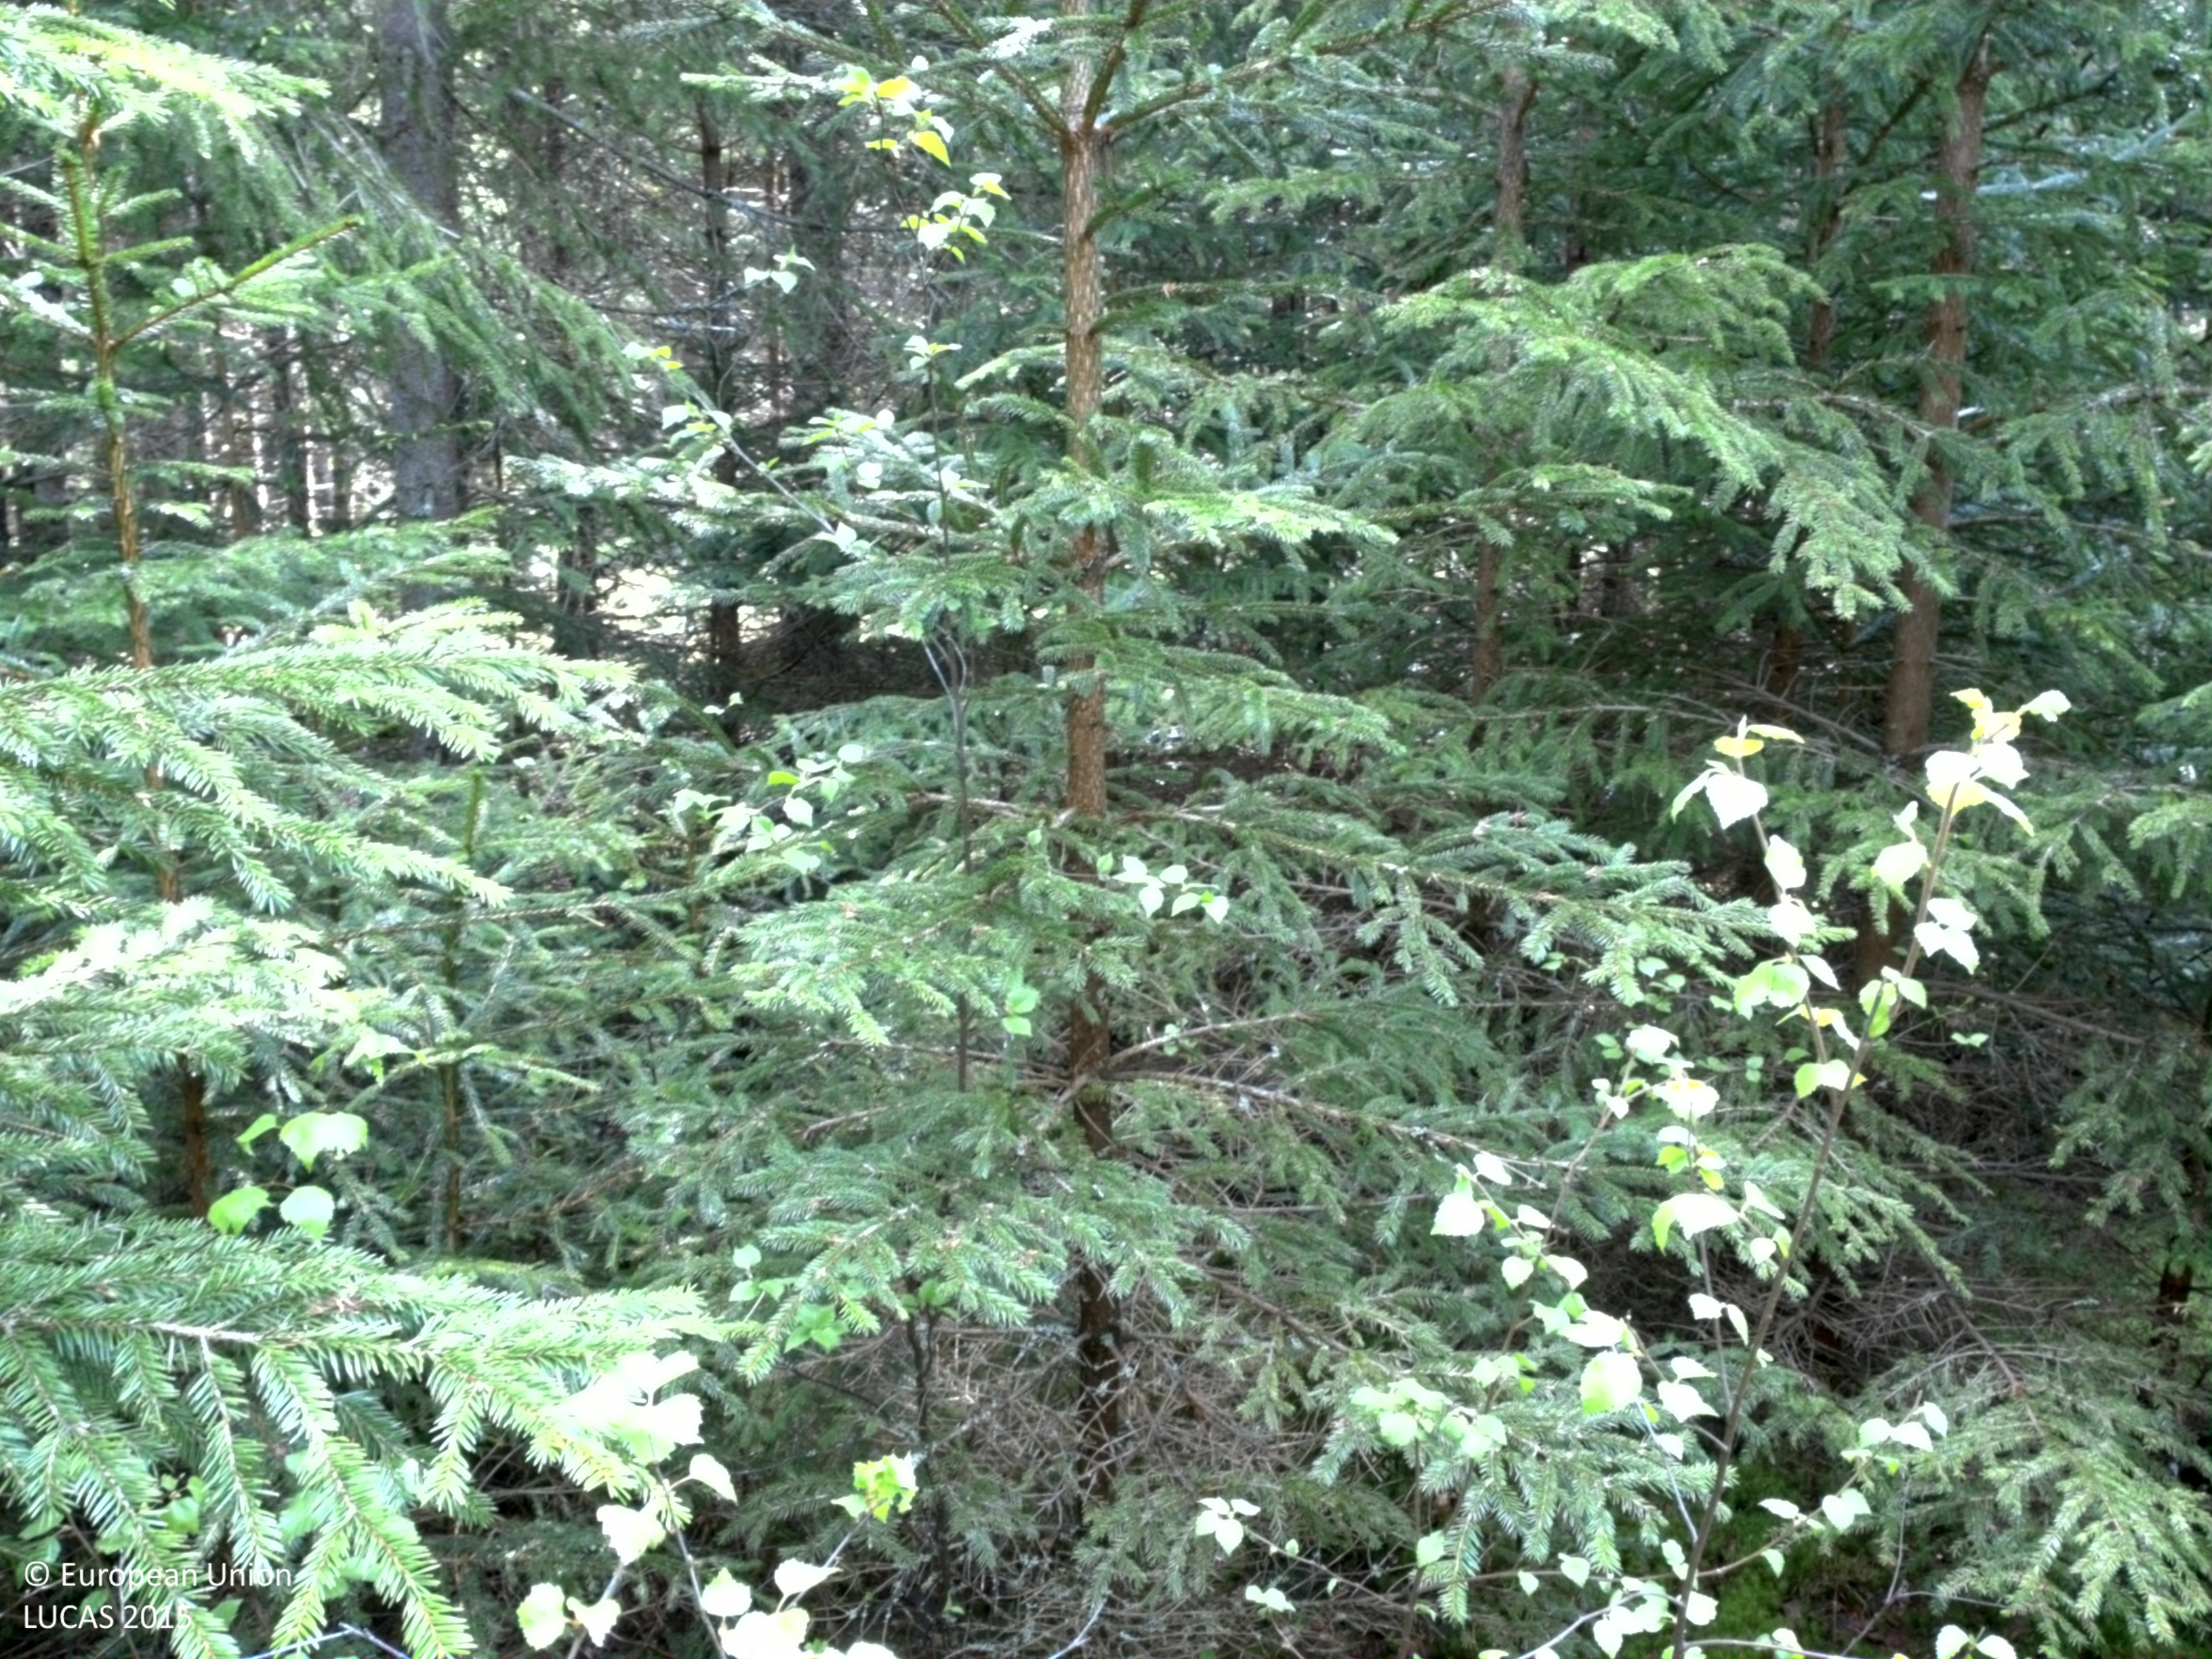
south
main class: Woodland
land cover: Spruce dominated mixed woodland
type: boreal forest
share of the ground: > 75 %
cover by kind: coniferous forest trees 75 %, broadleaved forest trees 25 %
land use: Forestry
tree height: < 5 m
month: May
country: SE
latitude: 56.5752
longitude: 15.4844
